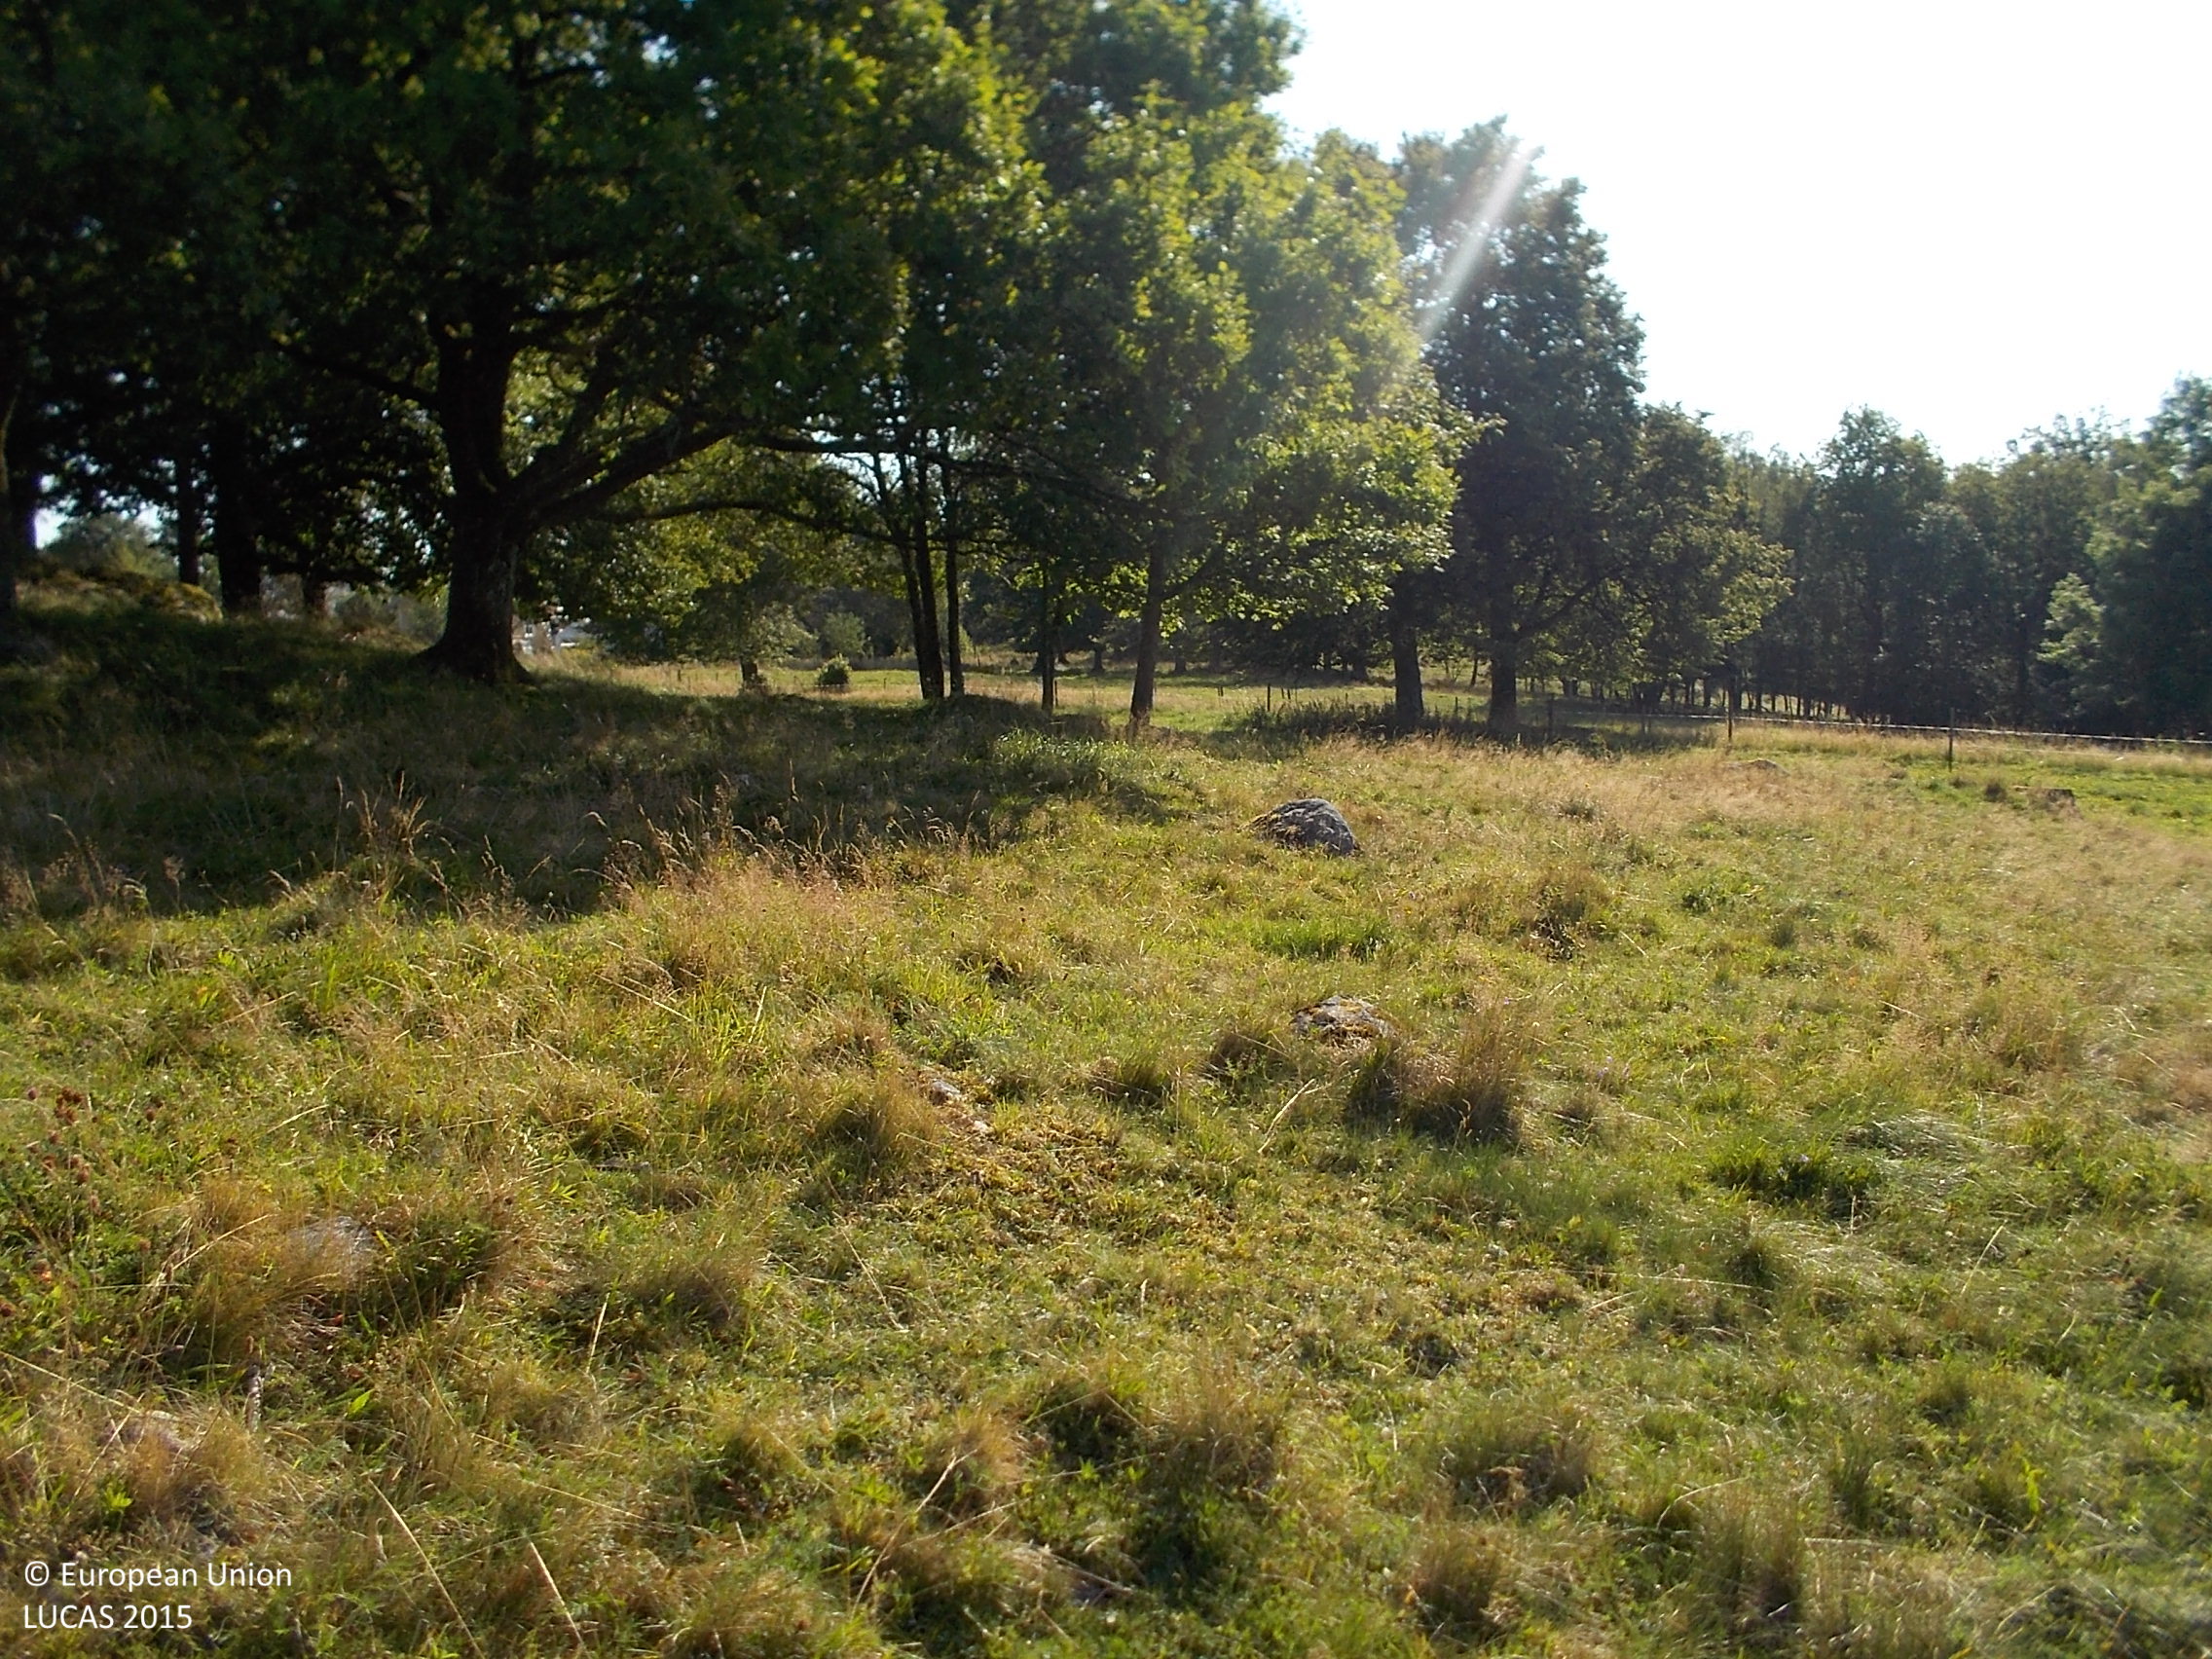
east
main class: Grassland
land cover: Grassland without tree/shrub cover
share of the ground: > 75 %
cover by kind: herbaceous plants 100 %
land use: Agriculture (excluding fallow land and kitchen gardens)
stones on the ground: < 10 %
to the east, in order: Grassland without tree/shrub cover; Electric lines; Broadleaved woodland; Grassland without tree/shrub cover; Fences; Grass margins; Tracks; Grass margins; Fences; Grassland without tree/shrub cover; Ditches and canals; Broadleaved woodland; Ditches and canals; Broadleaved woodland; Fences; Broadleaved woodland; Shrubland with sparse tree cover
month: August
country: SE
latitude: 57.4252
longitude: 13.2098
